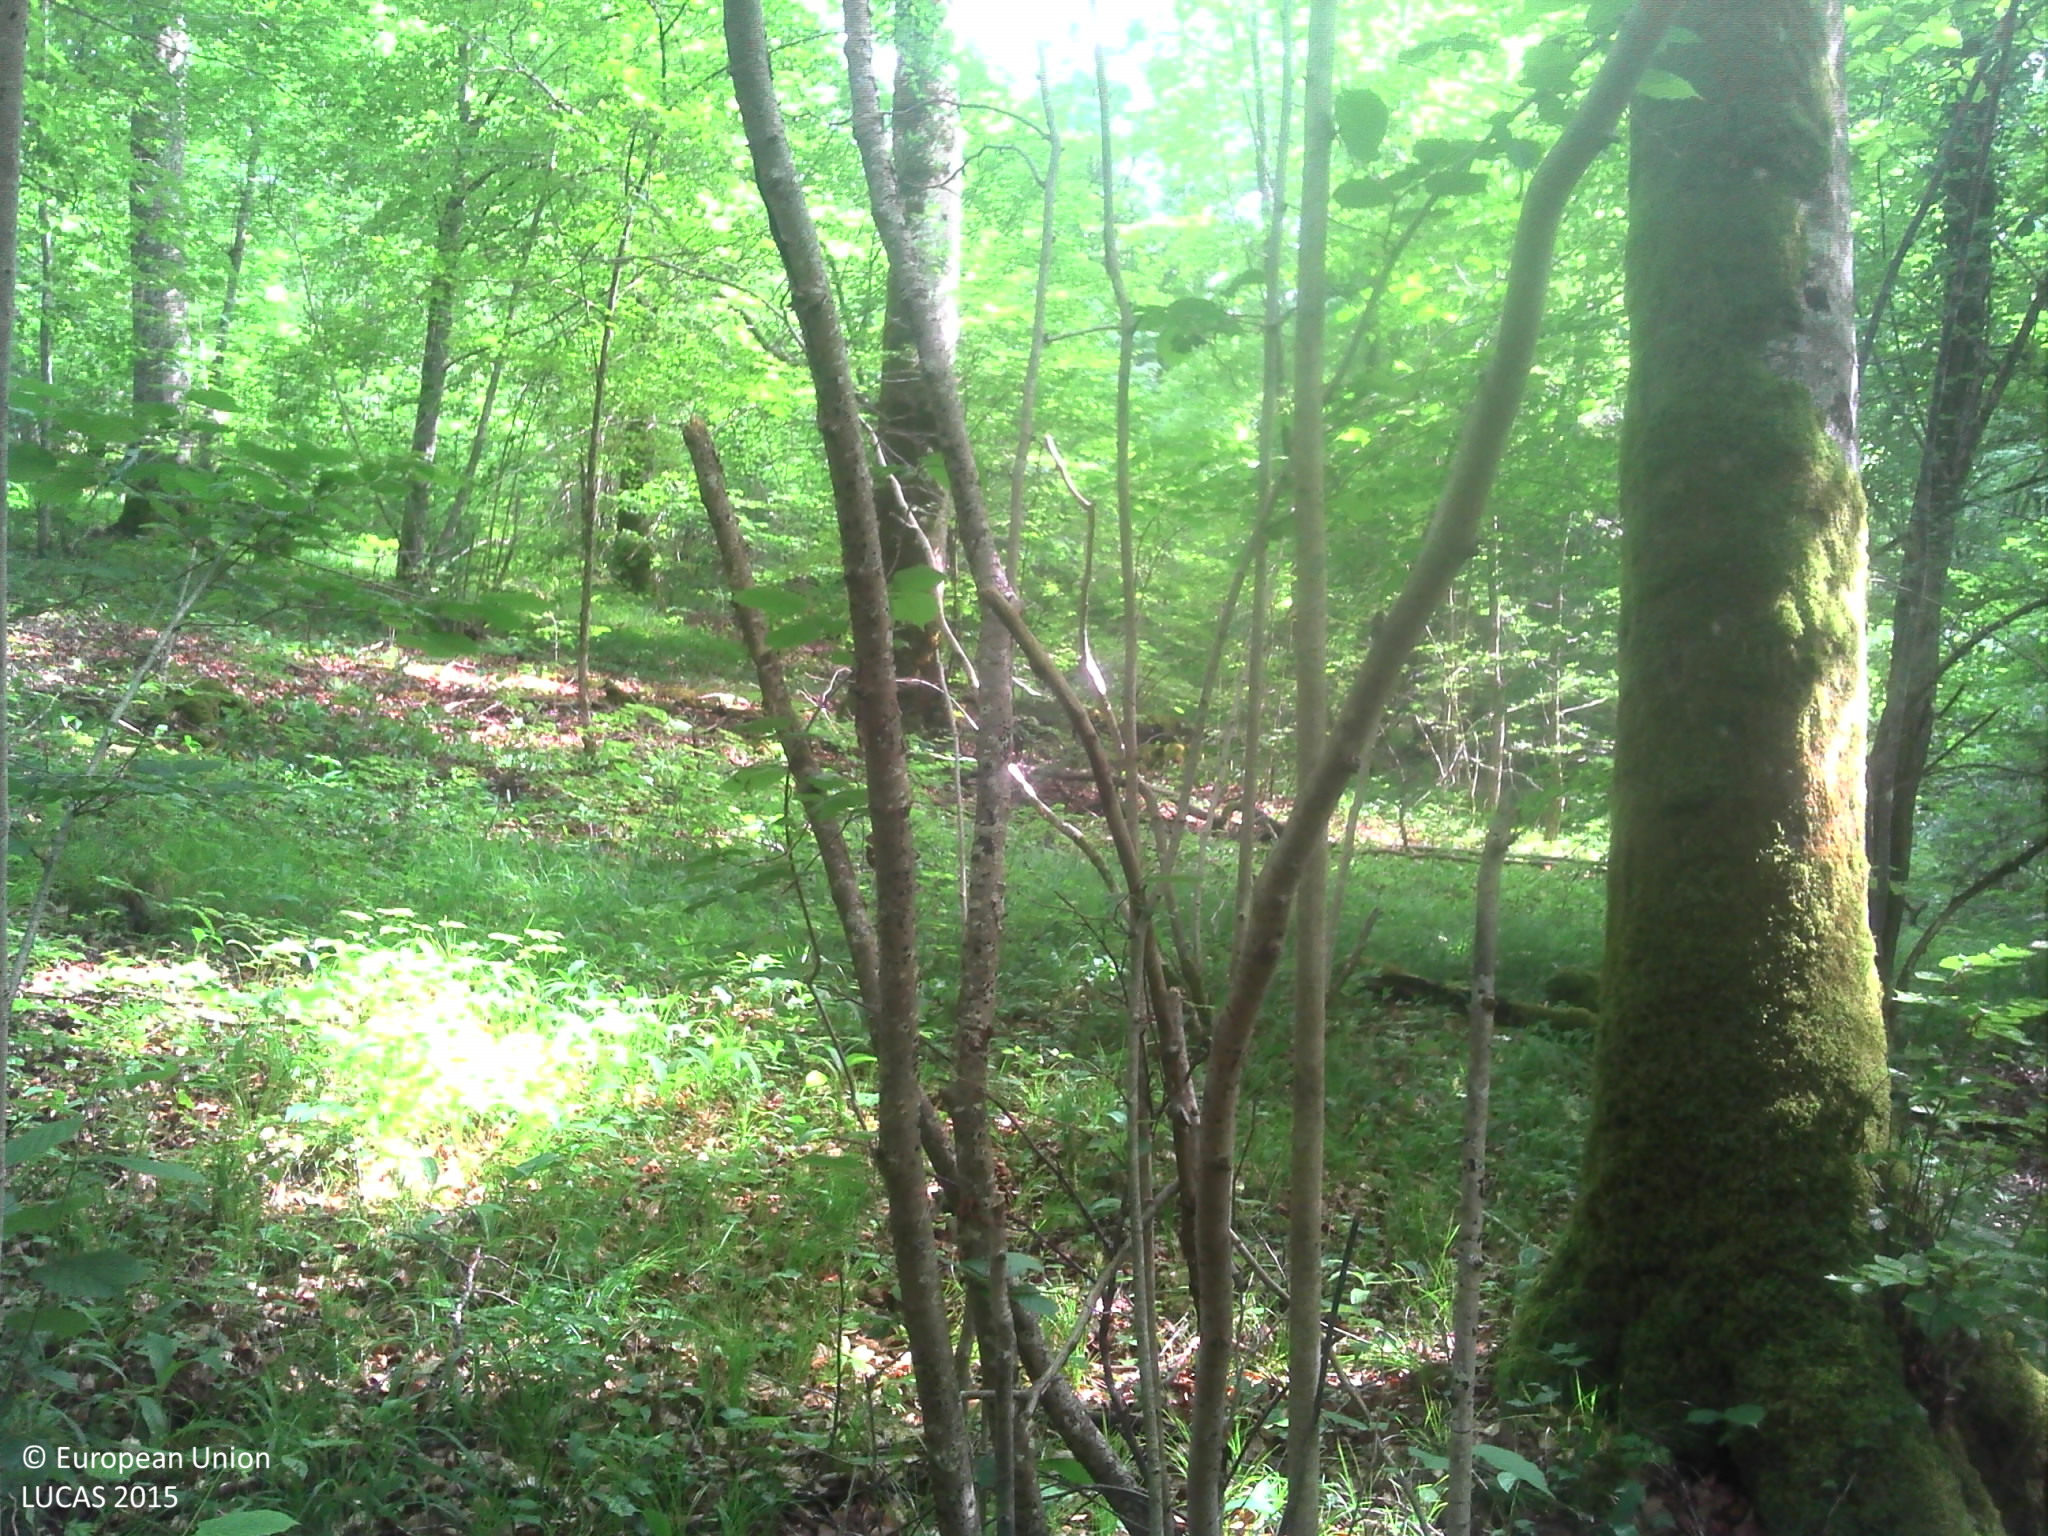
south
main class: Woodland
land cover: Broadleaved woodland
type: beech forest
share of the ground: > 75 %
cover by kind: broadleaved forest trees 80 %, coniferous forest trees 10 %, herbaceous plants 5 %, lichens and mosses 5 %
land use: Forestry
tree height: > 5 m
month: June
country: FR
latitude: 48.3167
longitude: 5.1848
